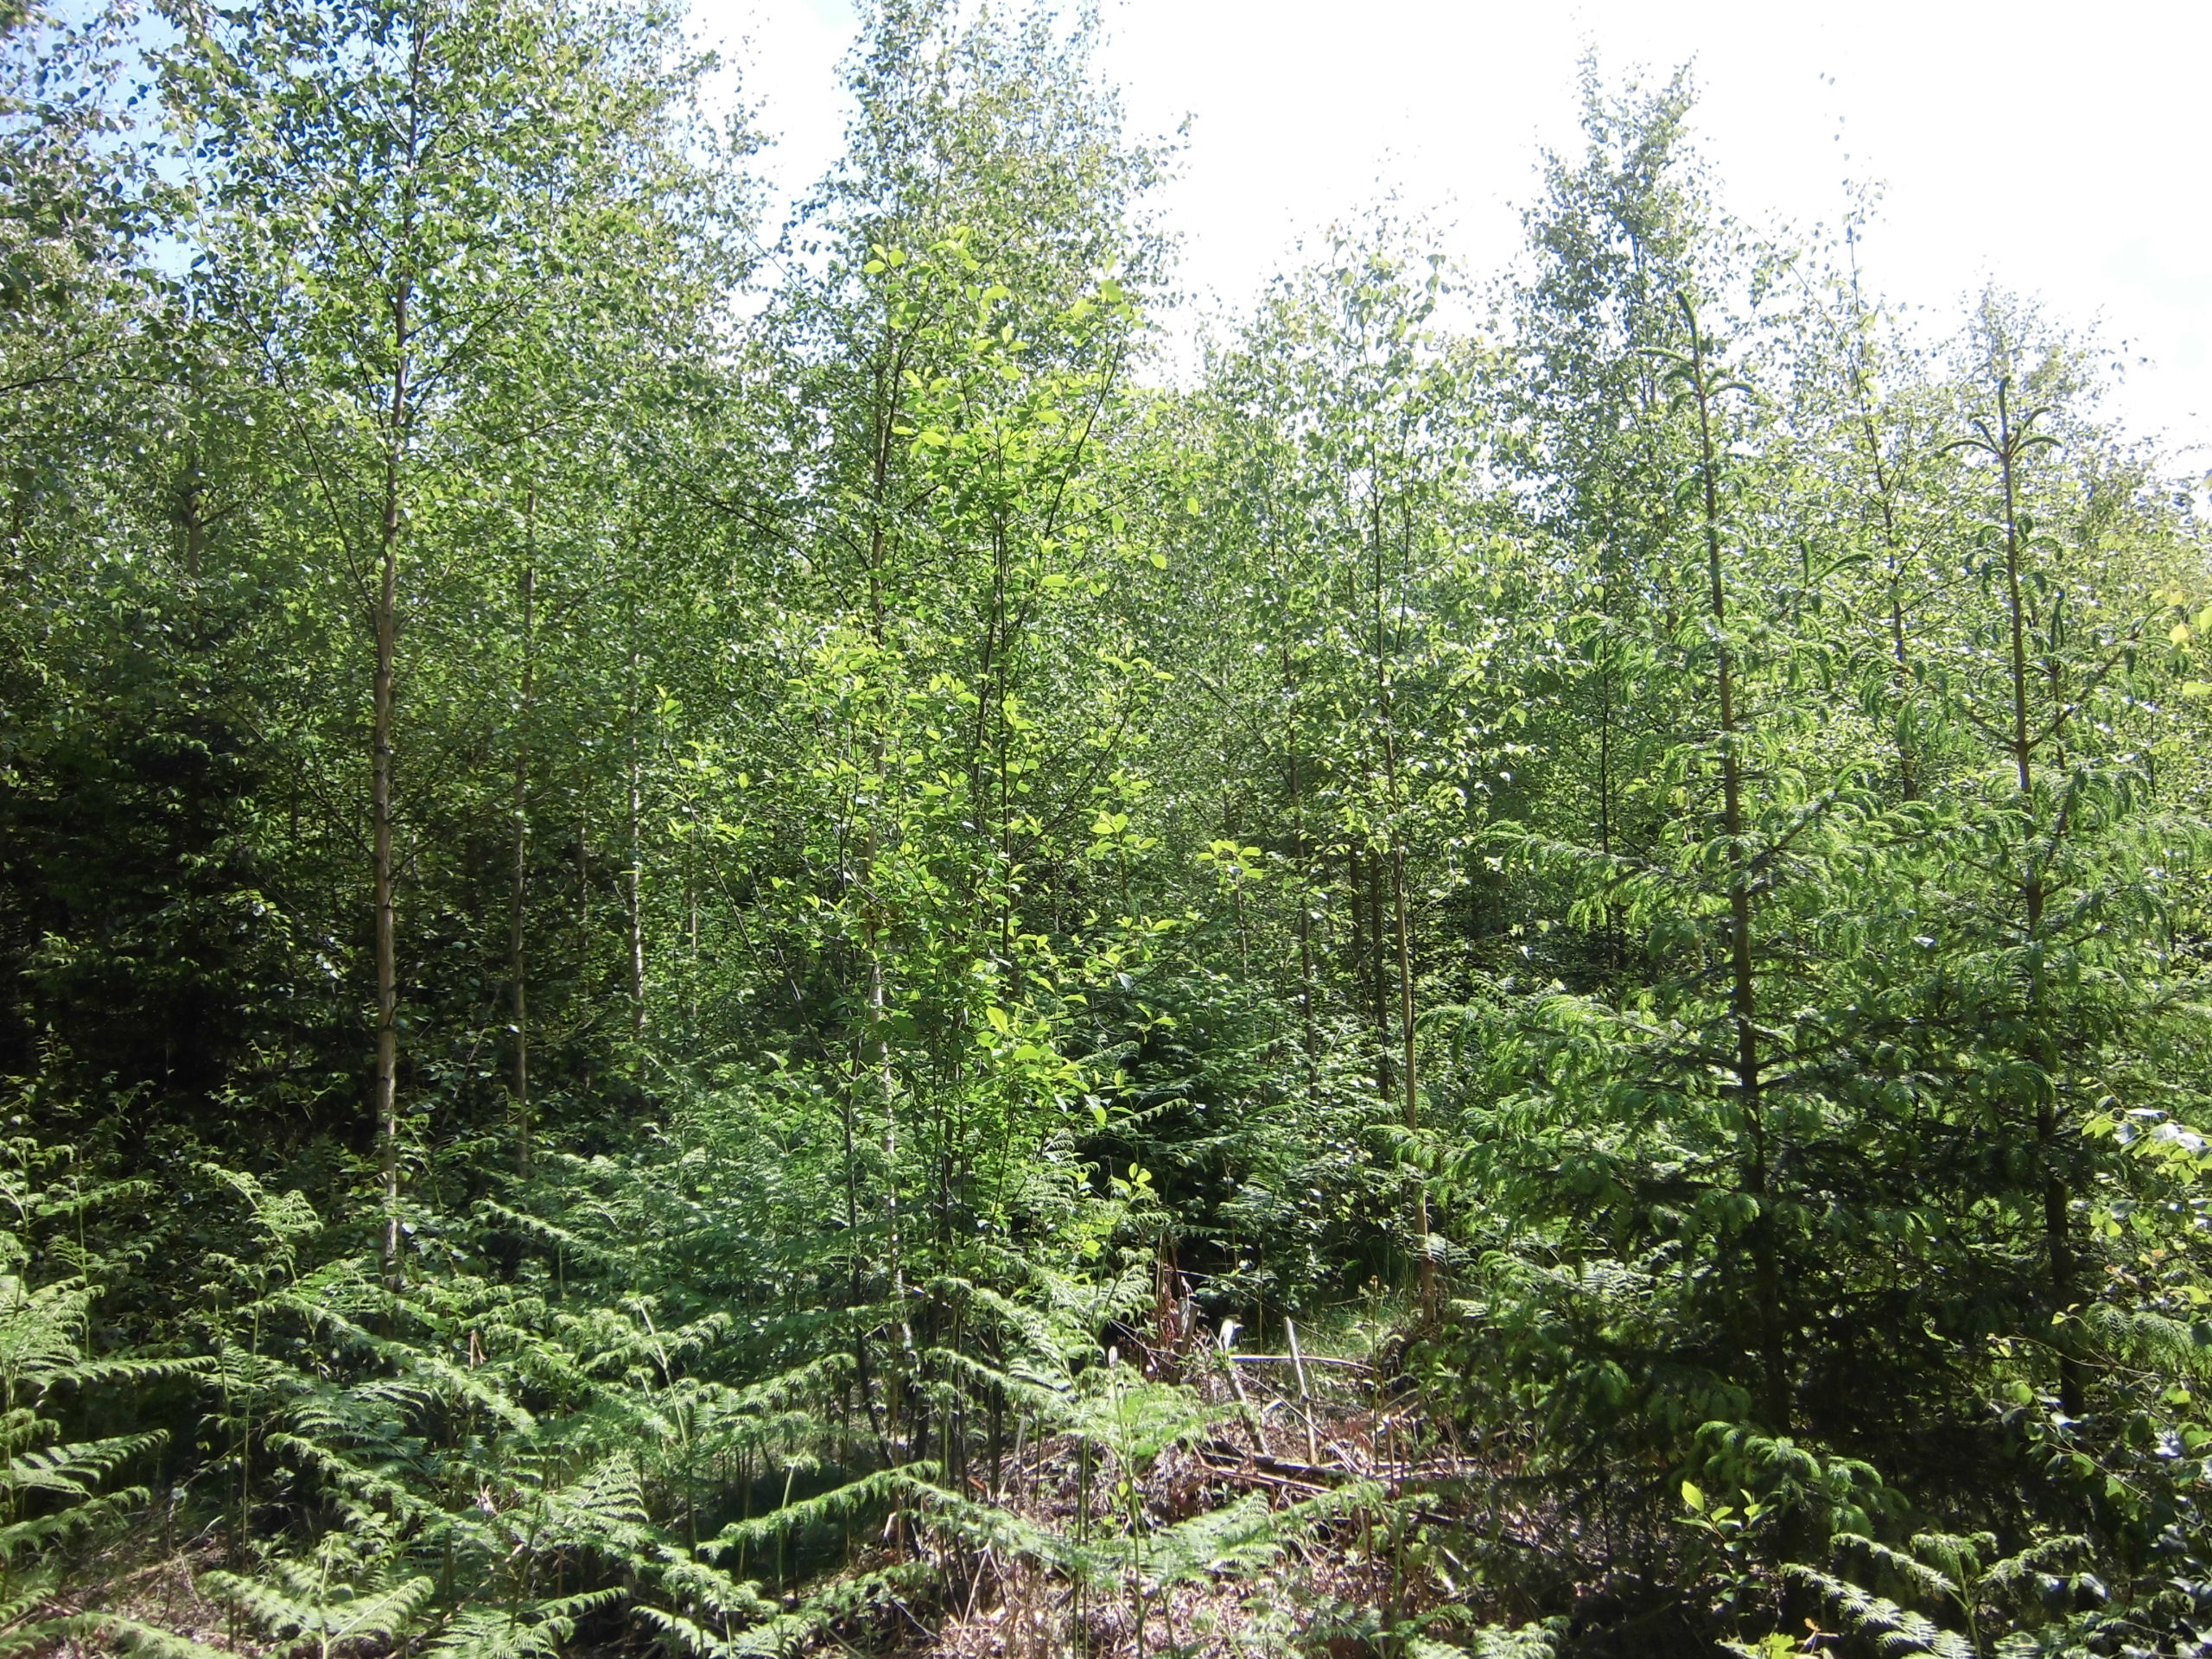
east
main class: Woodland
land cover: Broadleaved woodland
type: boreal forest
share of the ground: 50 - 75 %
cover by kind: broadleaved forest trees 55 %, herbaceous plants 20 %, coniferous forest trees 10 %, shrubs 10 %, lichens and mosses 5 %
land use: Forestry
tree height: > 5 m
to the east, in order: Broadleaved woodland; Spruce dominated mixed woodland; Broadleaved woodland; Spruce dominated mixed woodland; Spruce dominated coniferous woodland
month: June
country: SE
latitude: 56.9824
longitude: 14.7523
